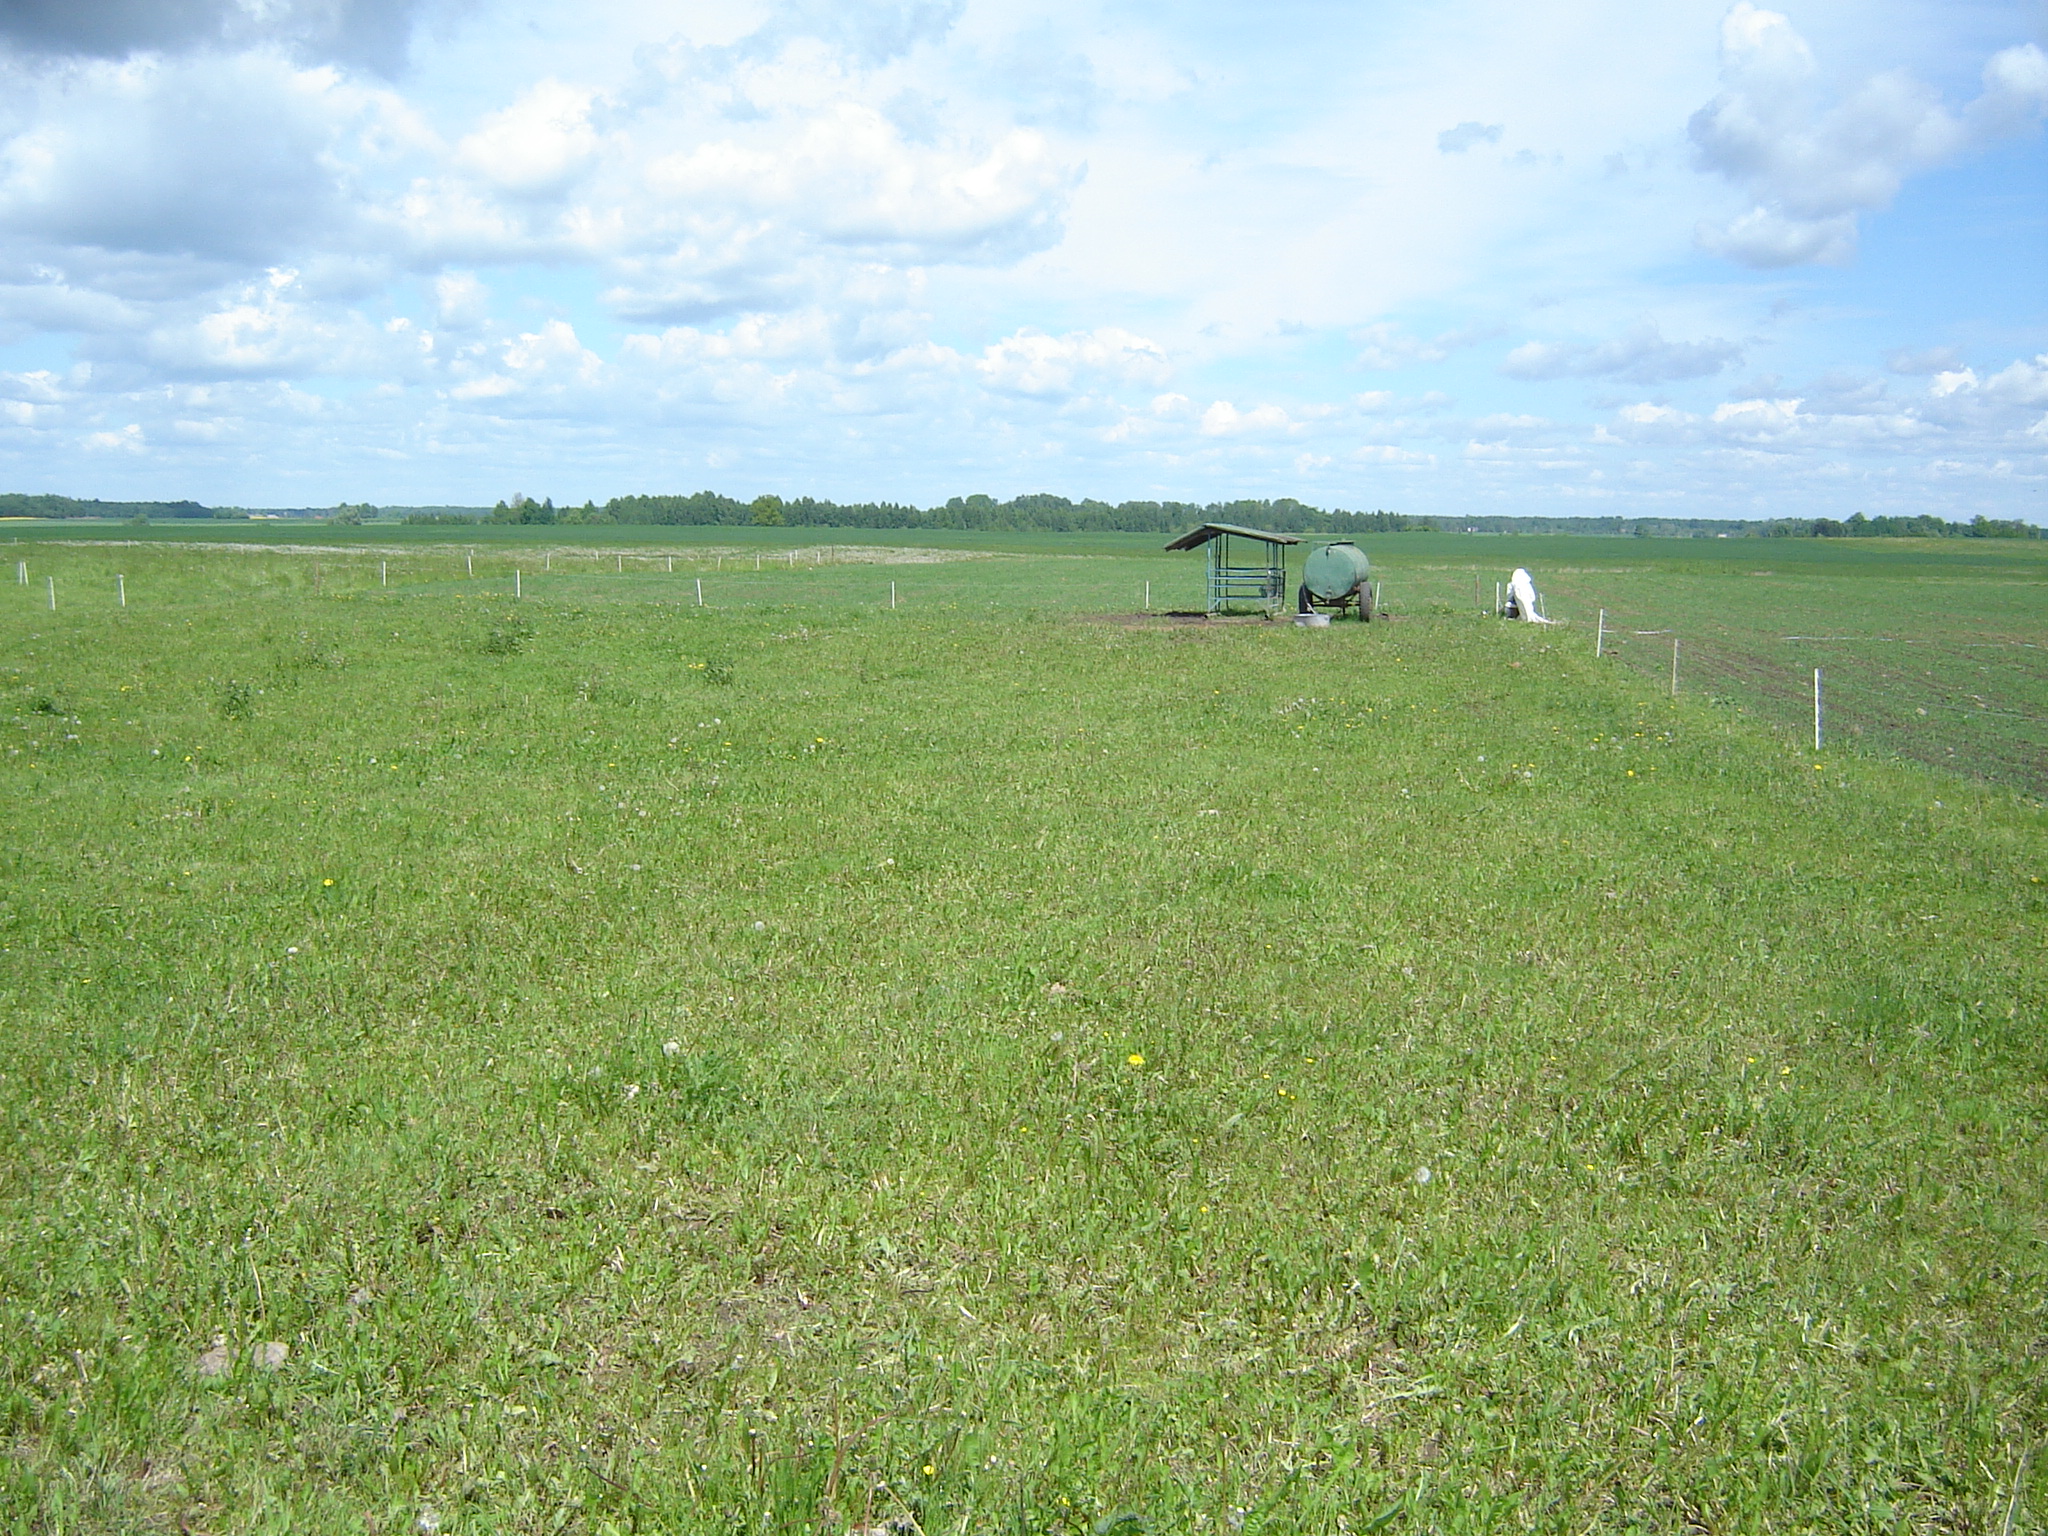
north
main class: Grassland
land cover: Grassland without tree/shrub cover
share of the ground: > 75 %
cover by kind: herbaceous plants 100 %
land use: Agriculture (excluding fallow land and kitchen gardens)
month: May
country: LT
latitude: 55.8070
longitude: 25.1931
